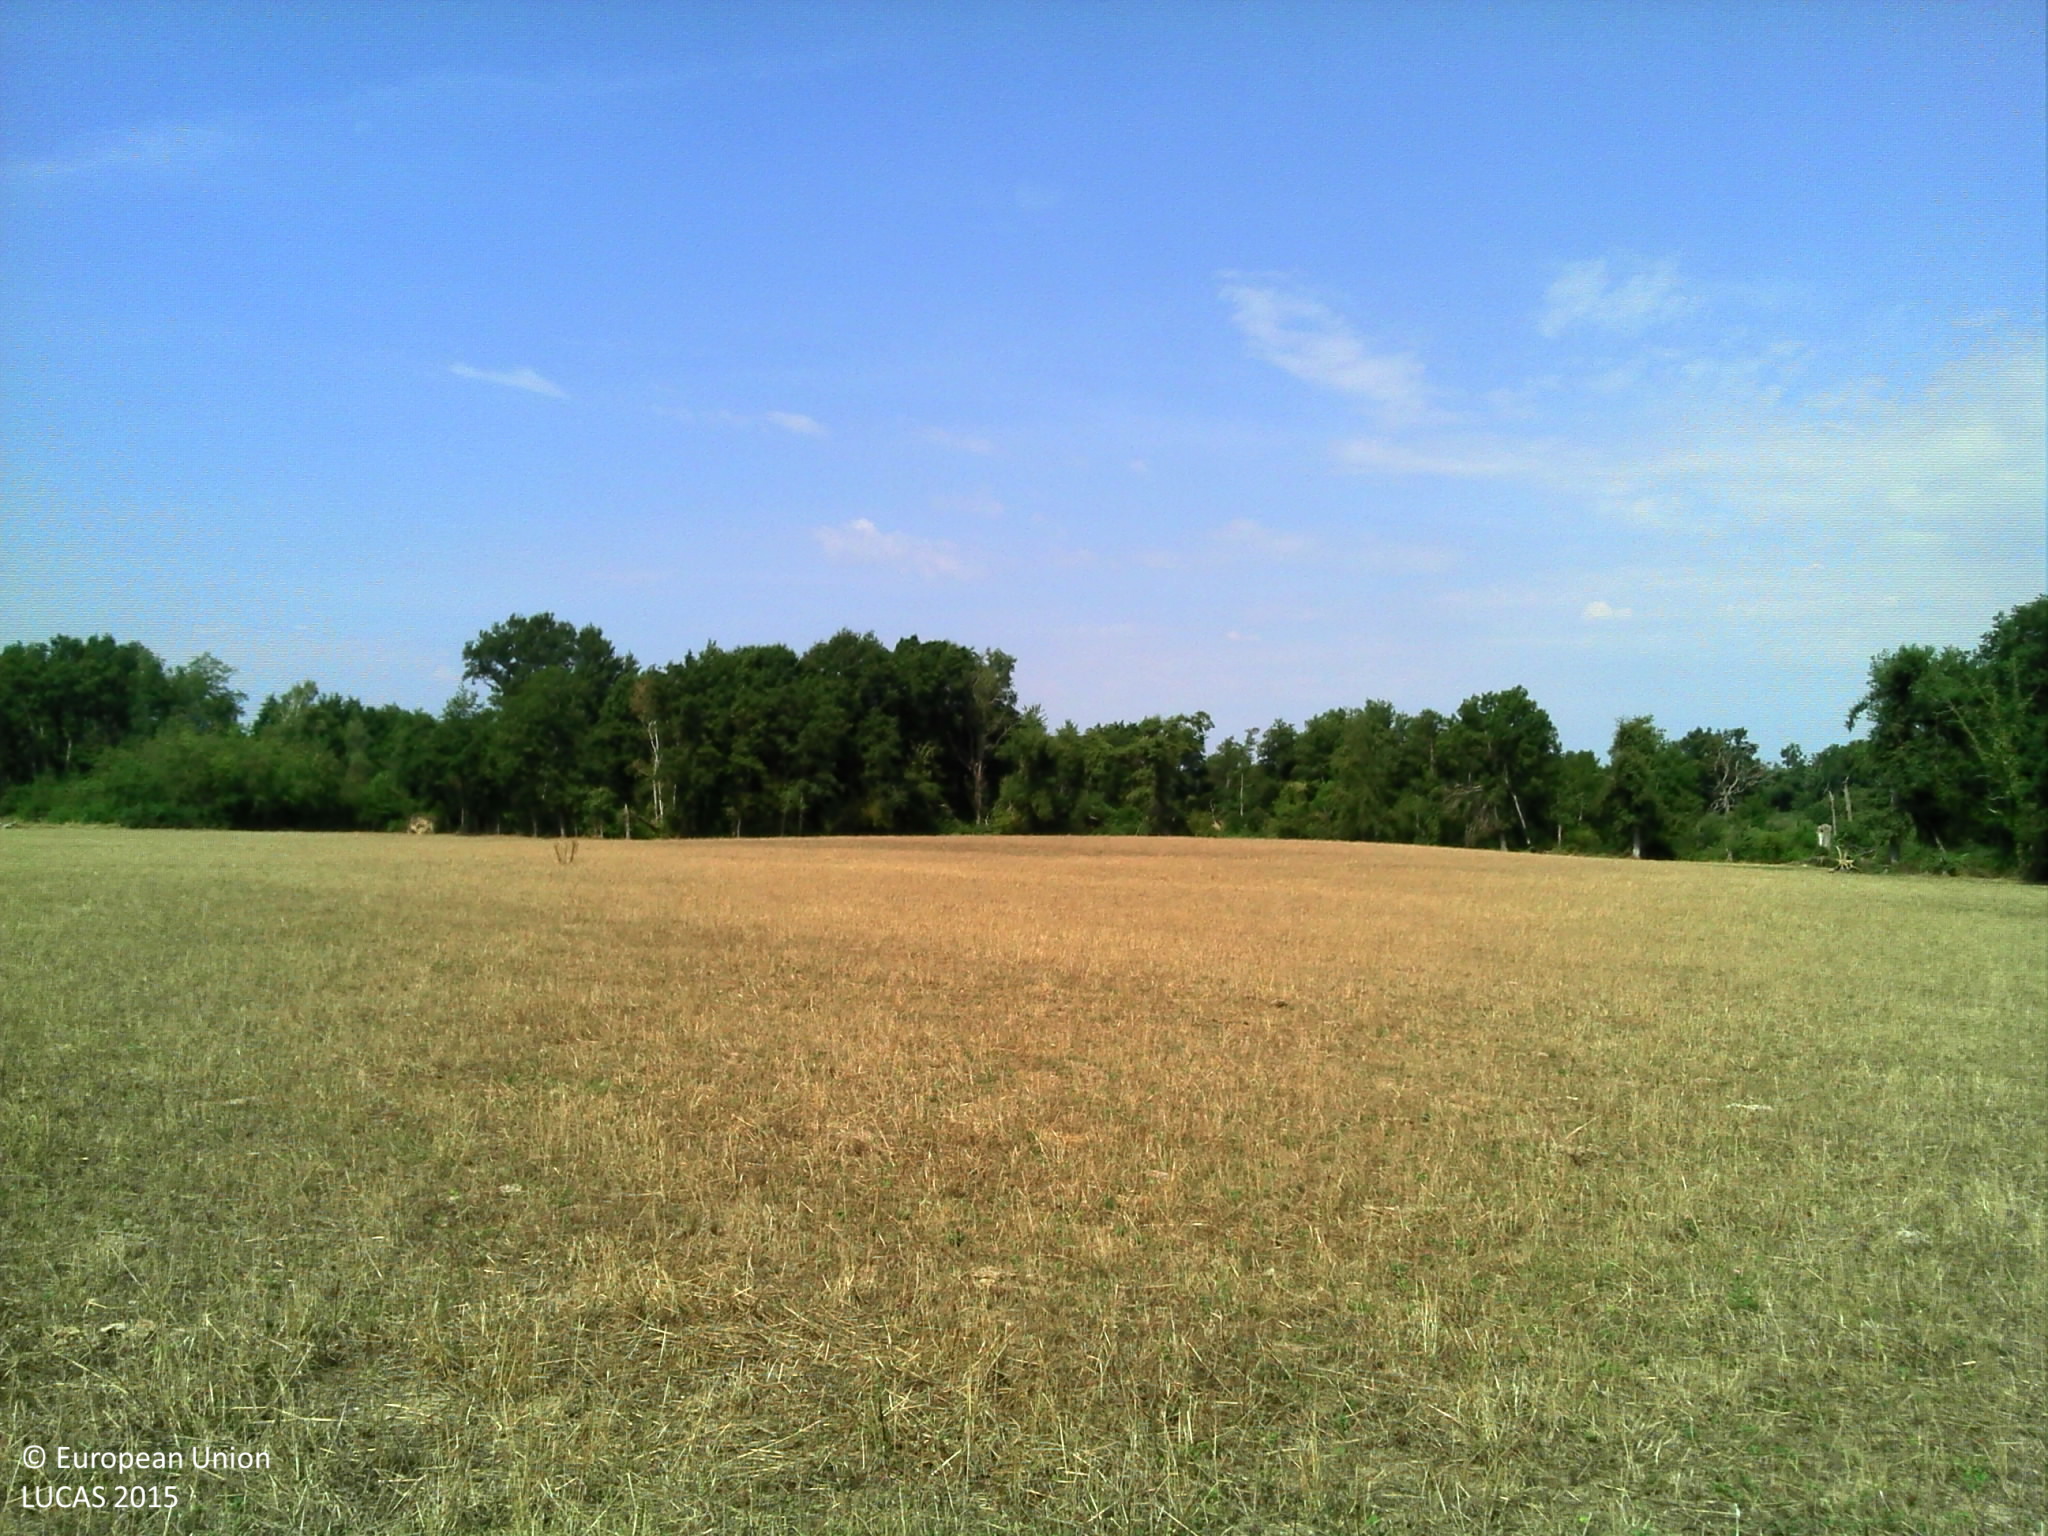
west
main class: Cropland
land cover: Temporary grasslands
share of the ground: > 75 %
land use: Agriculture (excluding fallow land and kitchen gardens)
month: August
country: FR
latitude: 46.6967
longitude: 2.9476
